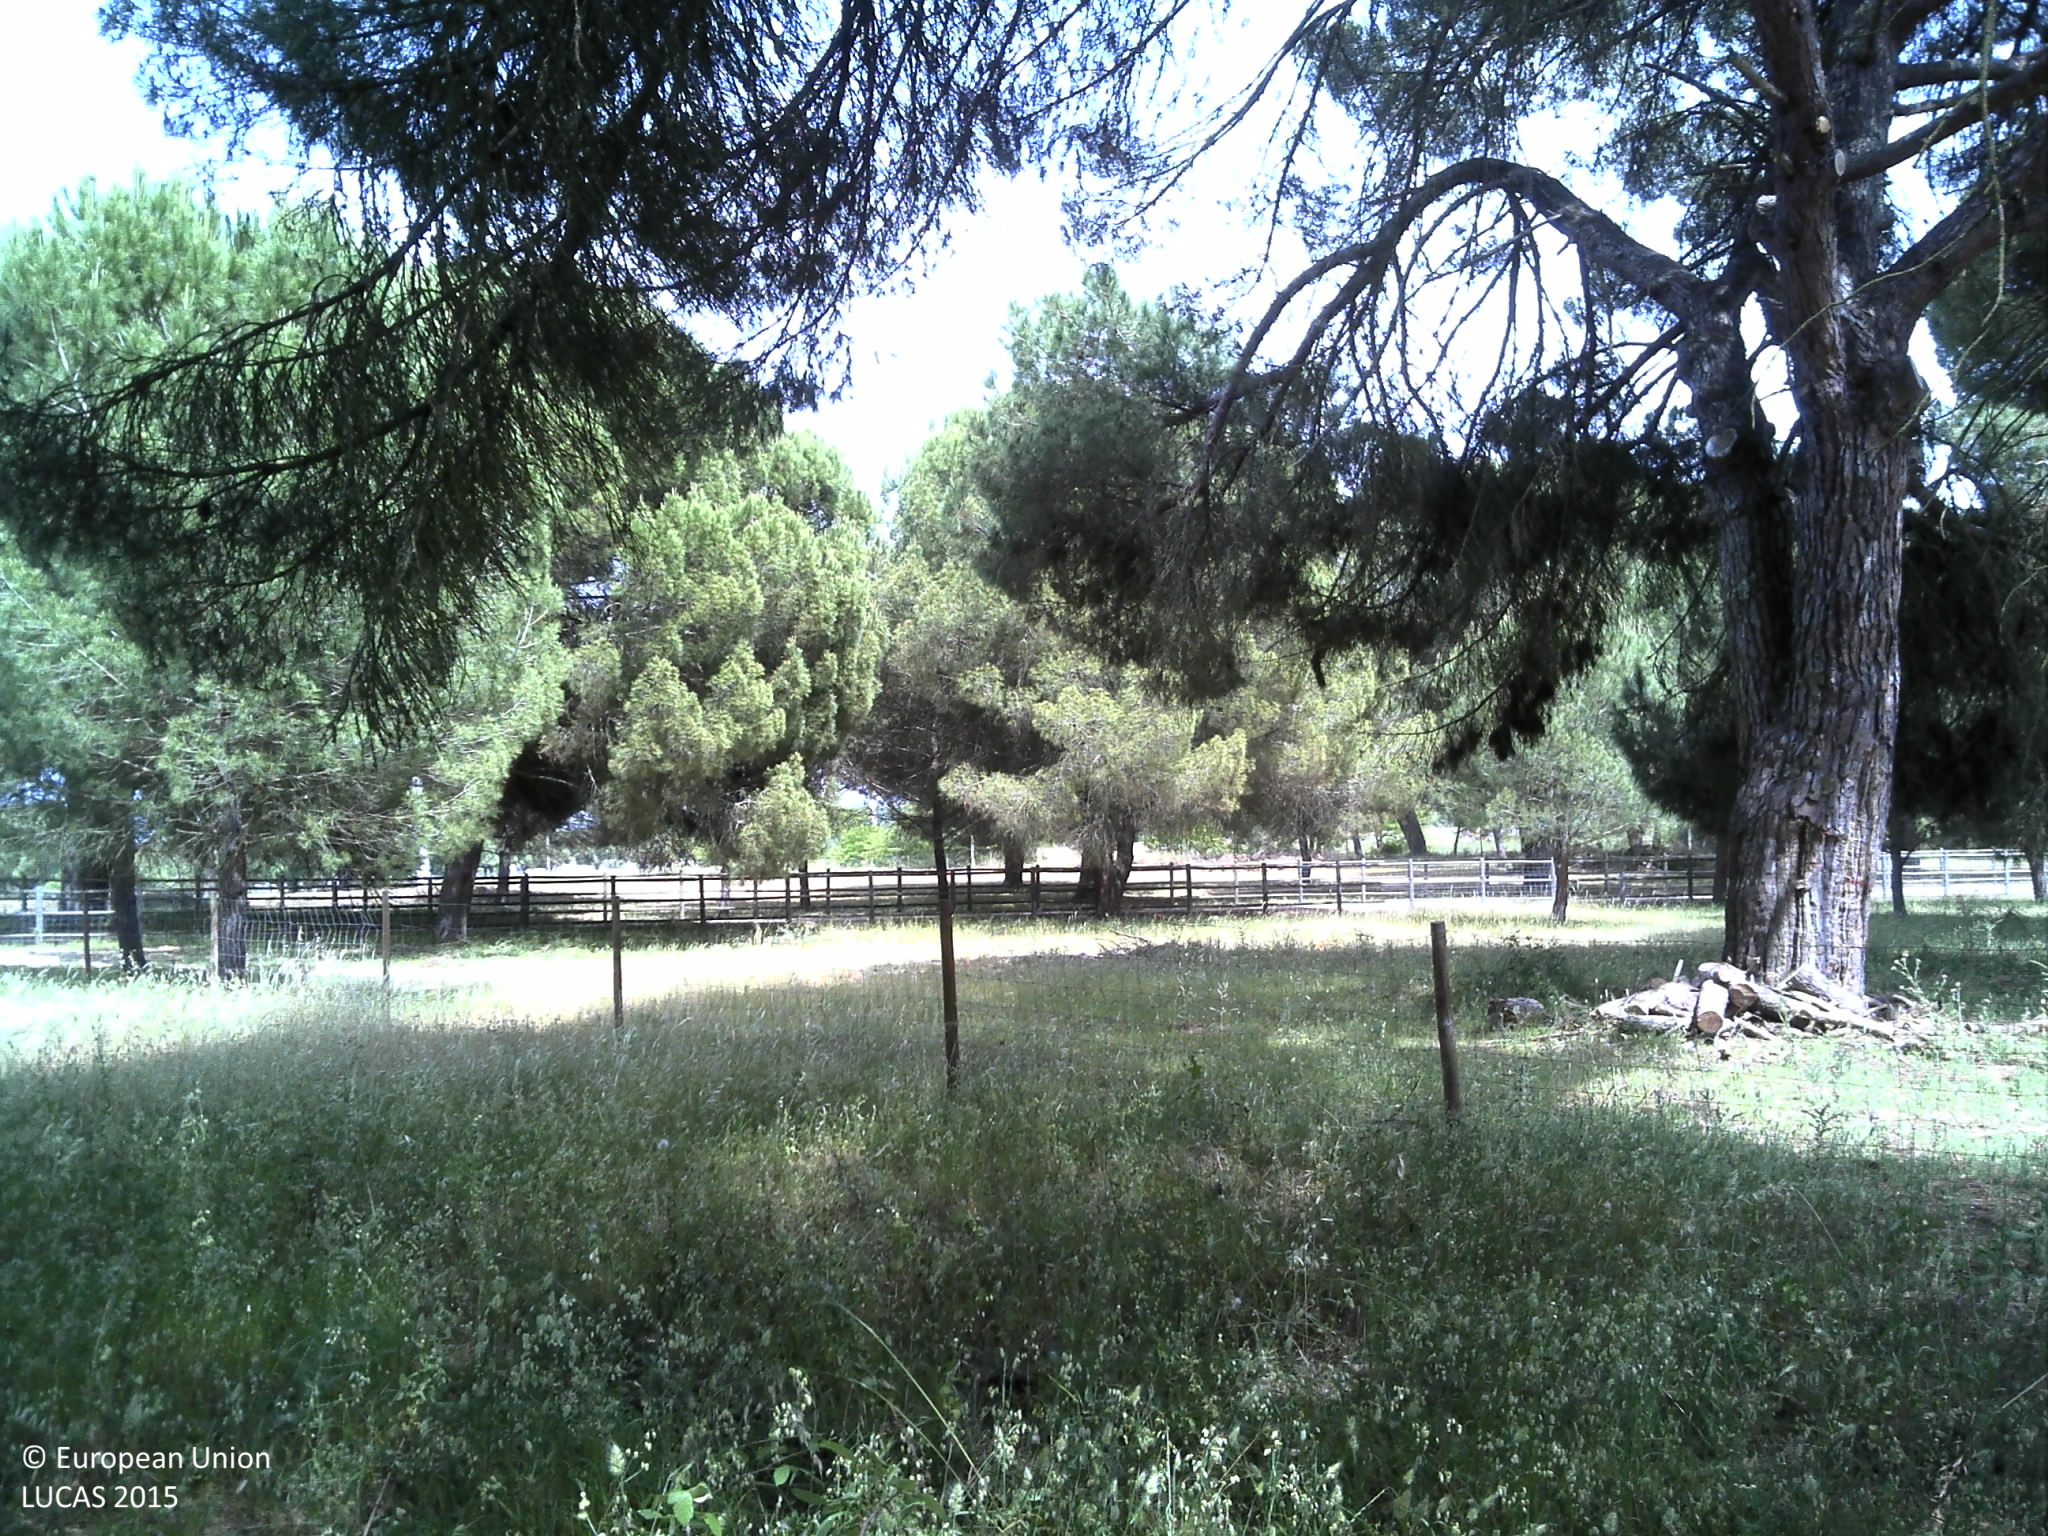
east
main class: Woodland
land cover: Pine dominated coniferous woodland
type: coniferous forest of the mediterranean region
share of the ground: > 75 %
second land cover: Spontaneously vegetated surfaces
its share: > 75 %
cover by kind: coniferous forest trees 75 %, herbaceous plants 25 %
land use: Forestry
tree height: > 5 m
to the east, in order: Pine dominated coniferous woodland; Spontaneously vegetated surfaces; Fences; Pine dominated coniferous woodland; Fences; Tracks; Fences; Pine dominated coniferous woodland; Spontaneously vegetated surfaces; Fences; Electric lines; Grassland with sparse tree/shrub cover; Fences; Grassland with sparse tree/shrub cover; Paved roads, cycling and walking lanes; Grassland without tree/shrub cover; Abandoned hedges; Fences; Spontaneously vegetated surfaces; Tracks; Grassland without tree/shrub cover
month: May
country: PT
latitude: 38.3853
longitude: -8.4702
